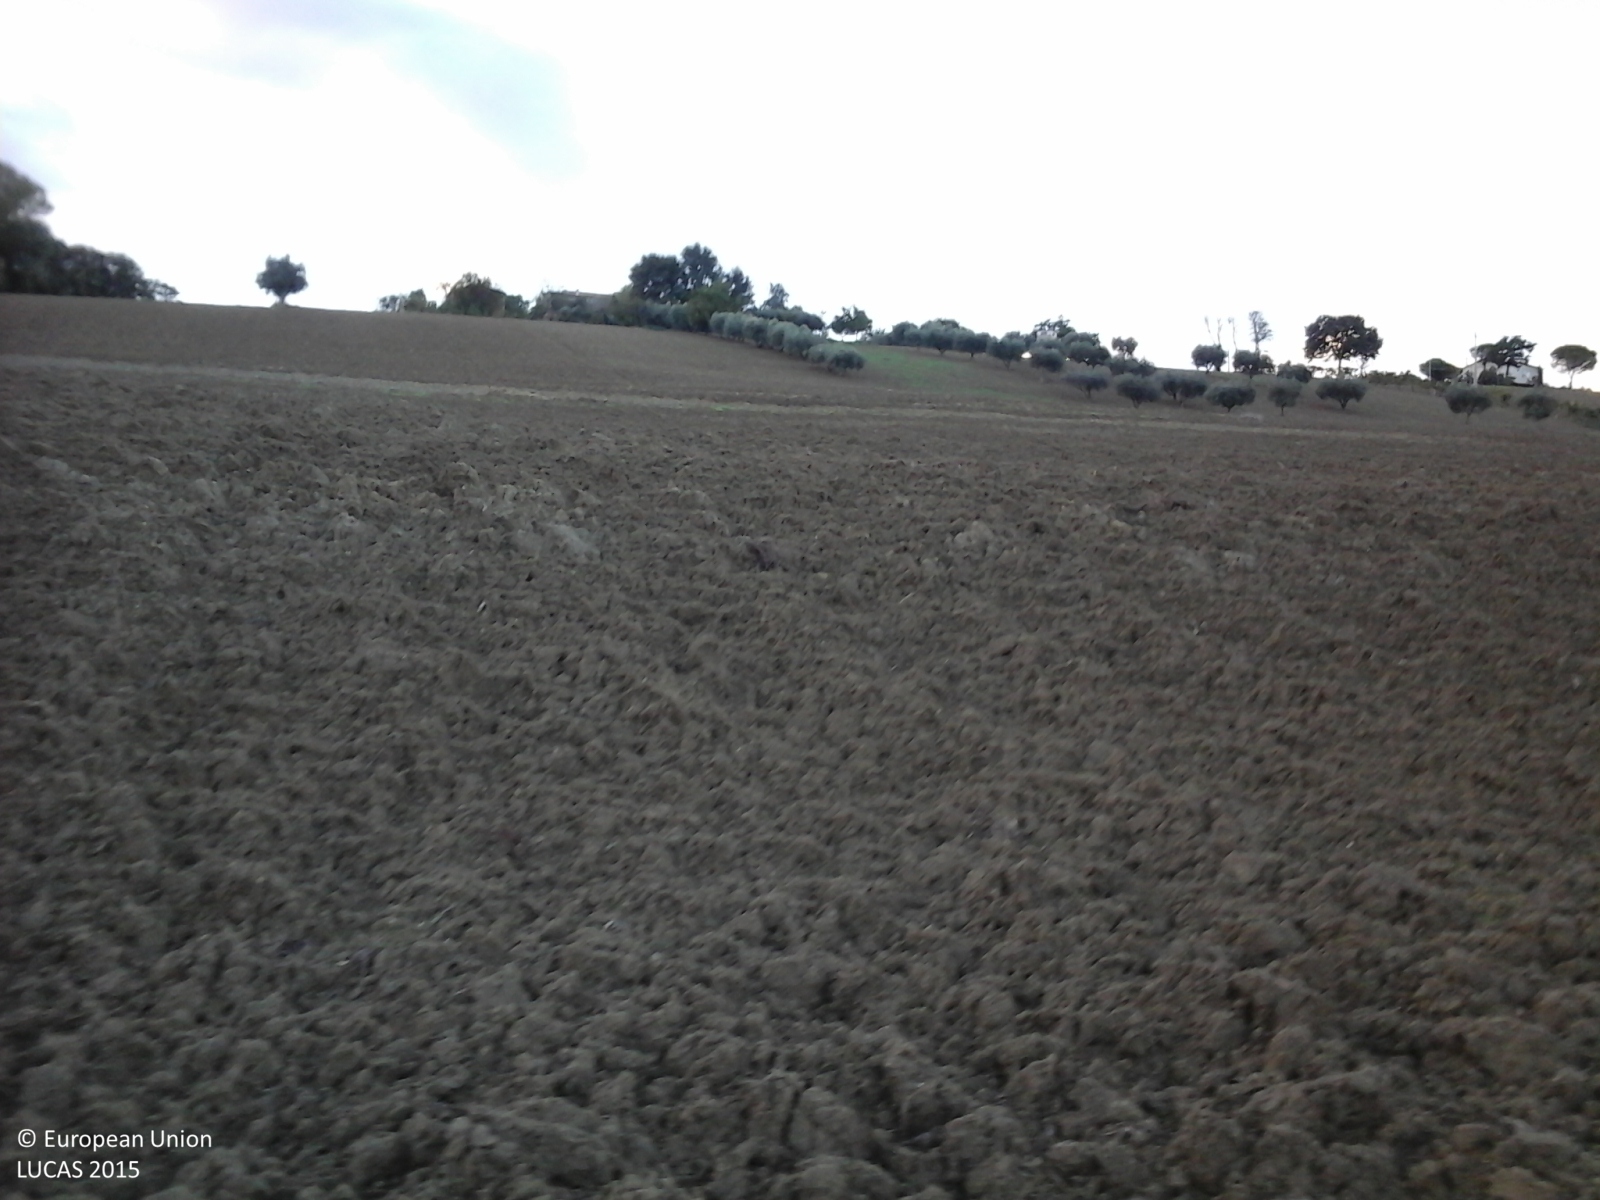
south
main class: Cropland
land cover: Durum wheat
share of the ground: < 10 %
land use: Agriculture (excluding fallow land and kitchen gardens)
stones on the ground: < 10 %
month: October
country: IT
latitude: 43.5963
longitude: 13.2252
